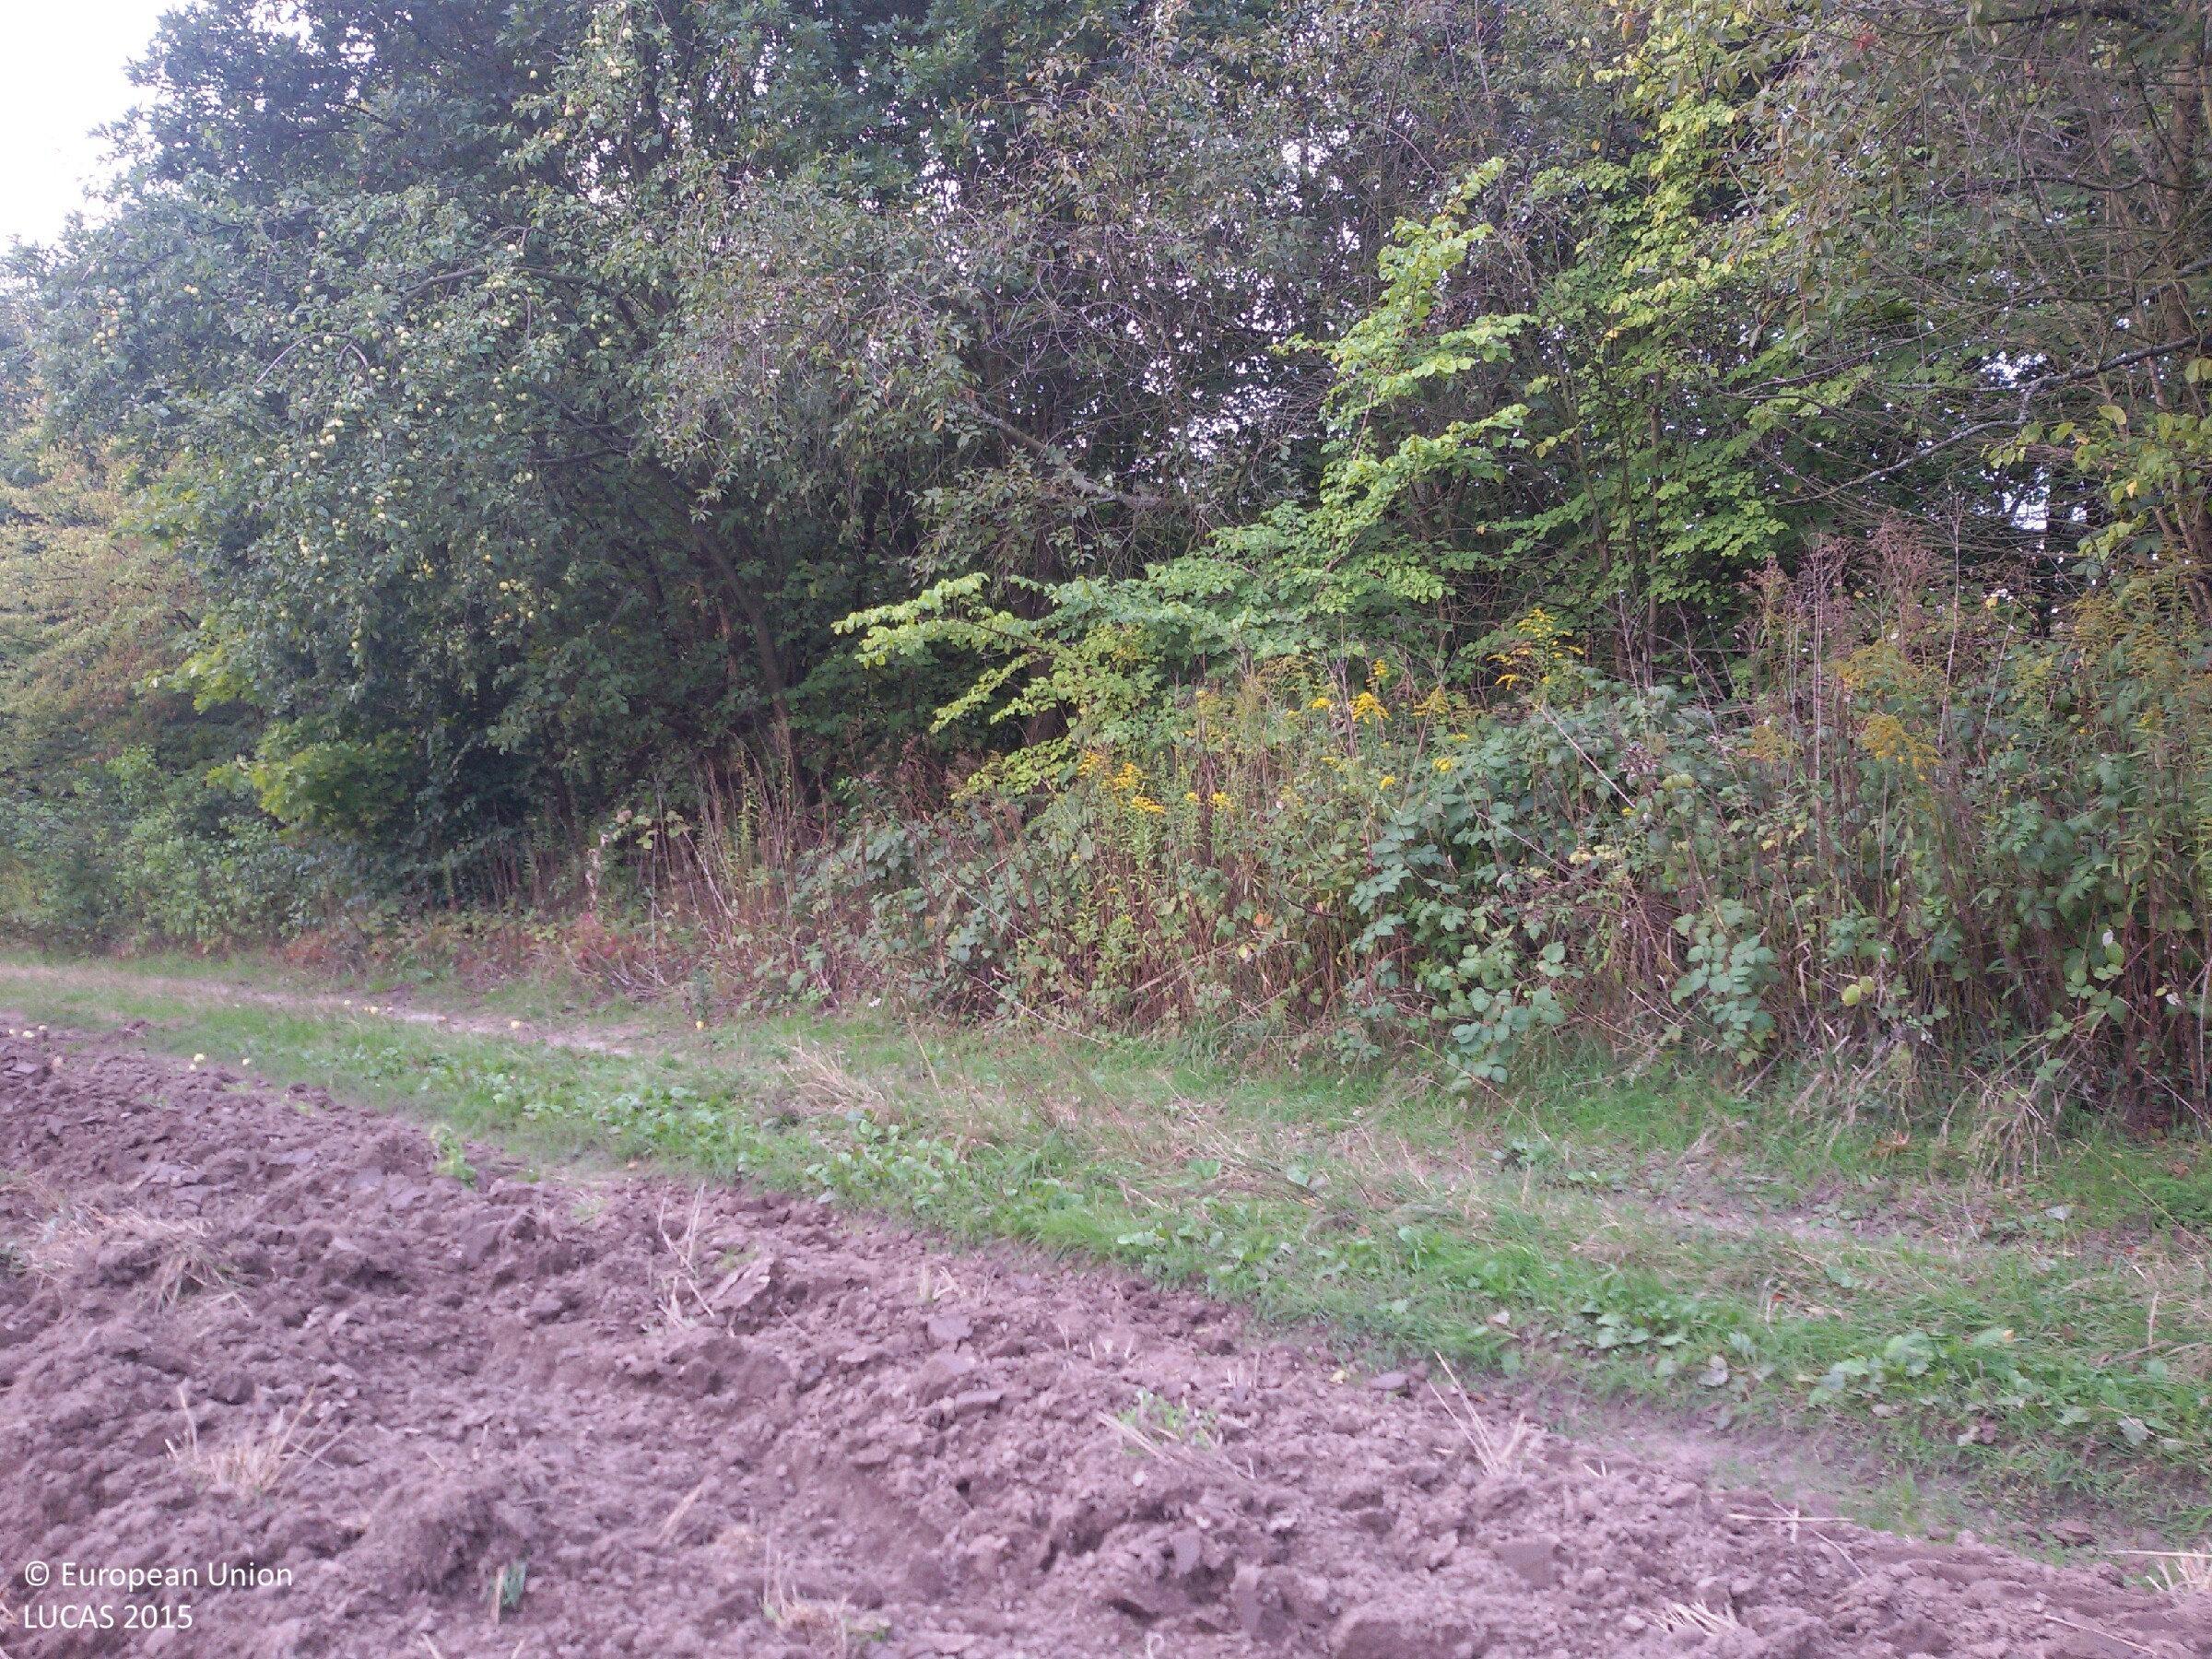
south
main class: Cropland
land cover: Triticale
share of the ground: 10 - 25 %
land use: Agriculture (excluding fallow land and kitchen gardens)
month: September
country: PL
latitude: 54.2128
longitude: 19.3938
